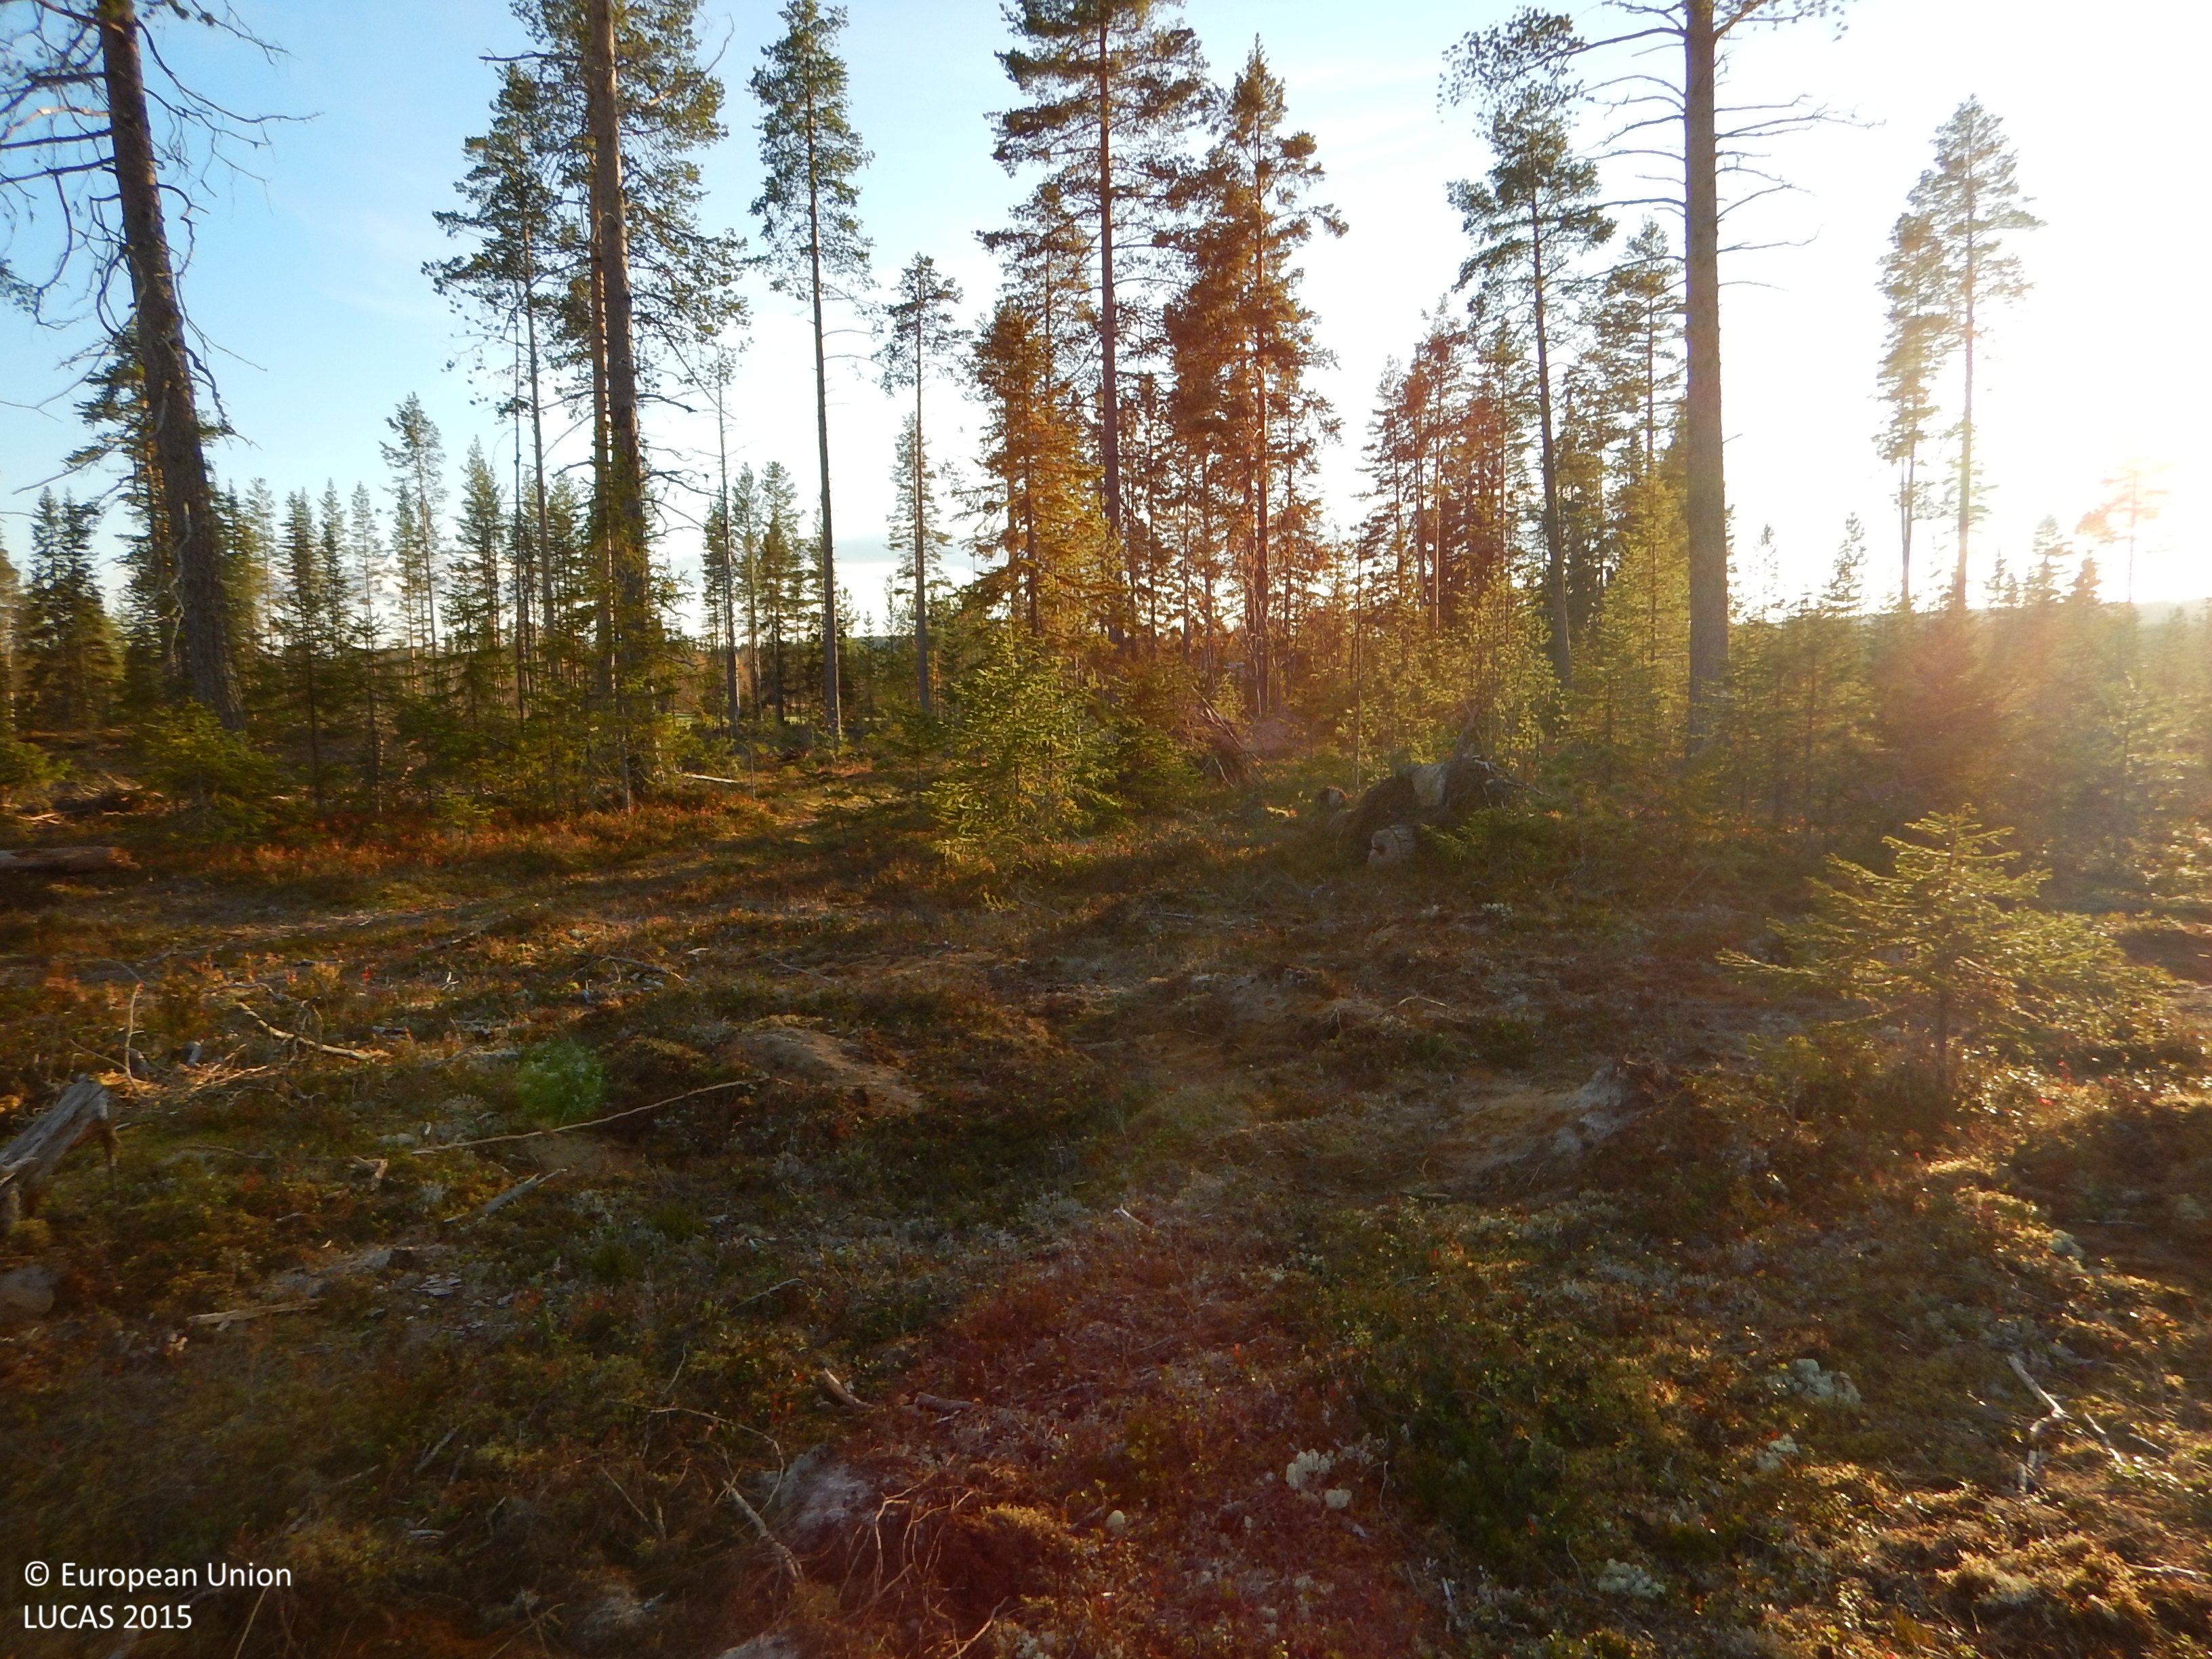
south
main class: Woodland
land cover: Pine dominated coniferous woodland
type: boreal forest
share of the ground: 10 - 25 %
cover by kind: shrubs 40 %, lichens and mosses 30 %, herbaceous plants 20 %, coniferous forest trees 10 %
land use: Forestry
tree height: > 5 m
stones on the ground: < 10 %
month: October
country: SE
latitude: 65.1059
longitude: 20.8103
